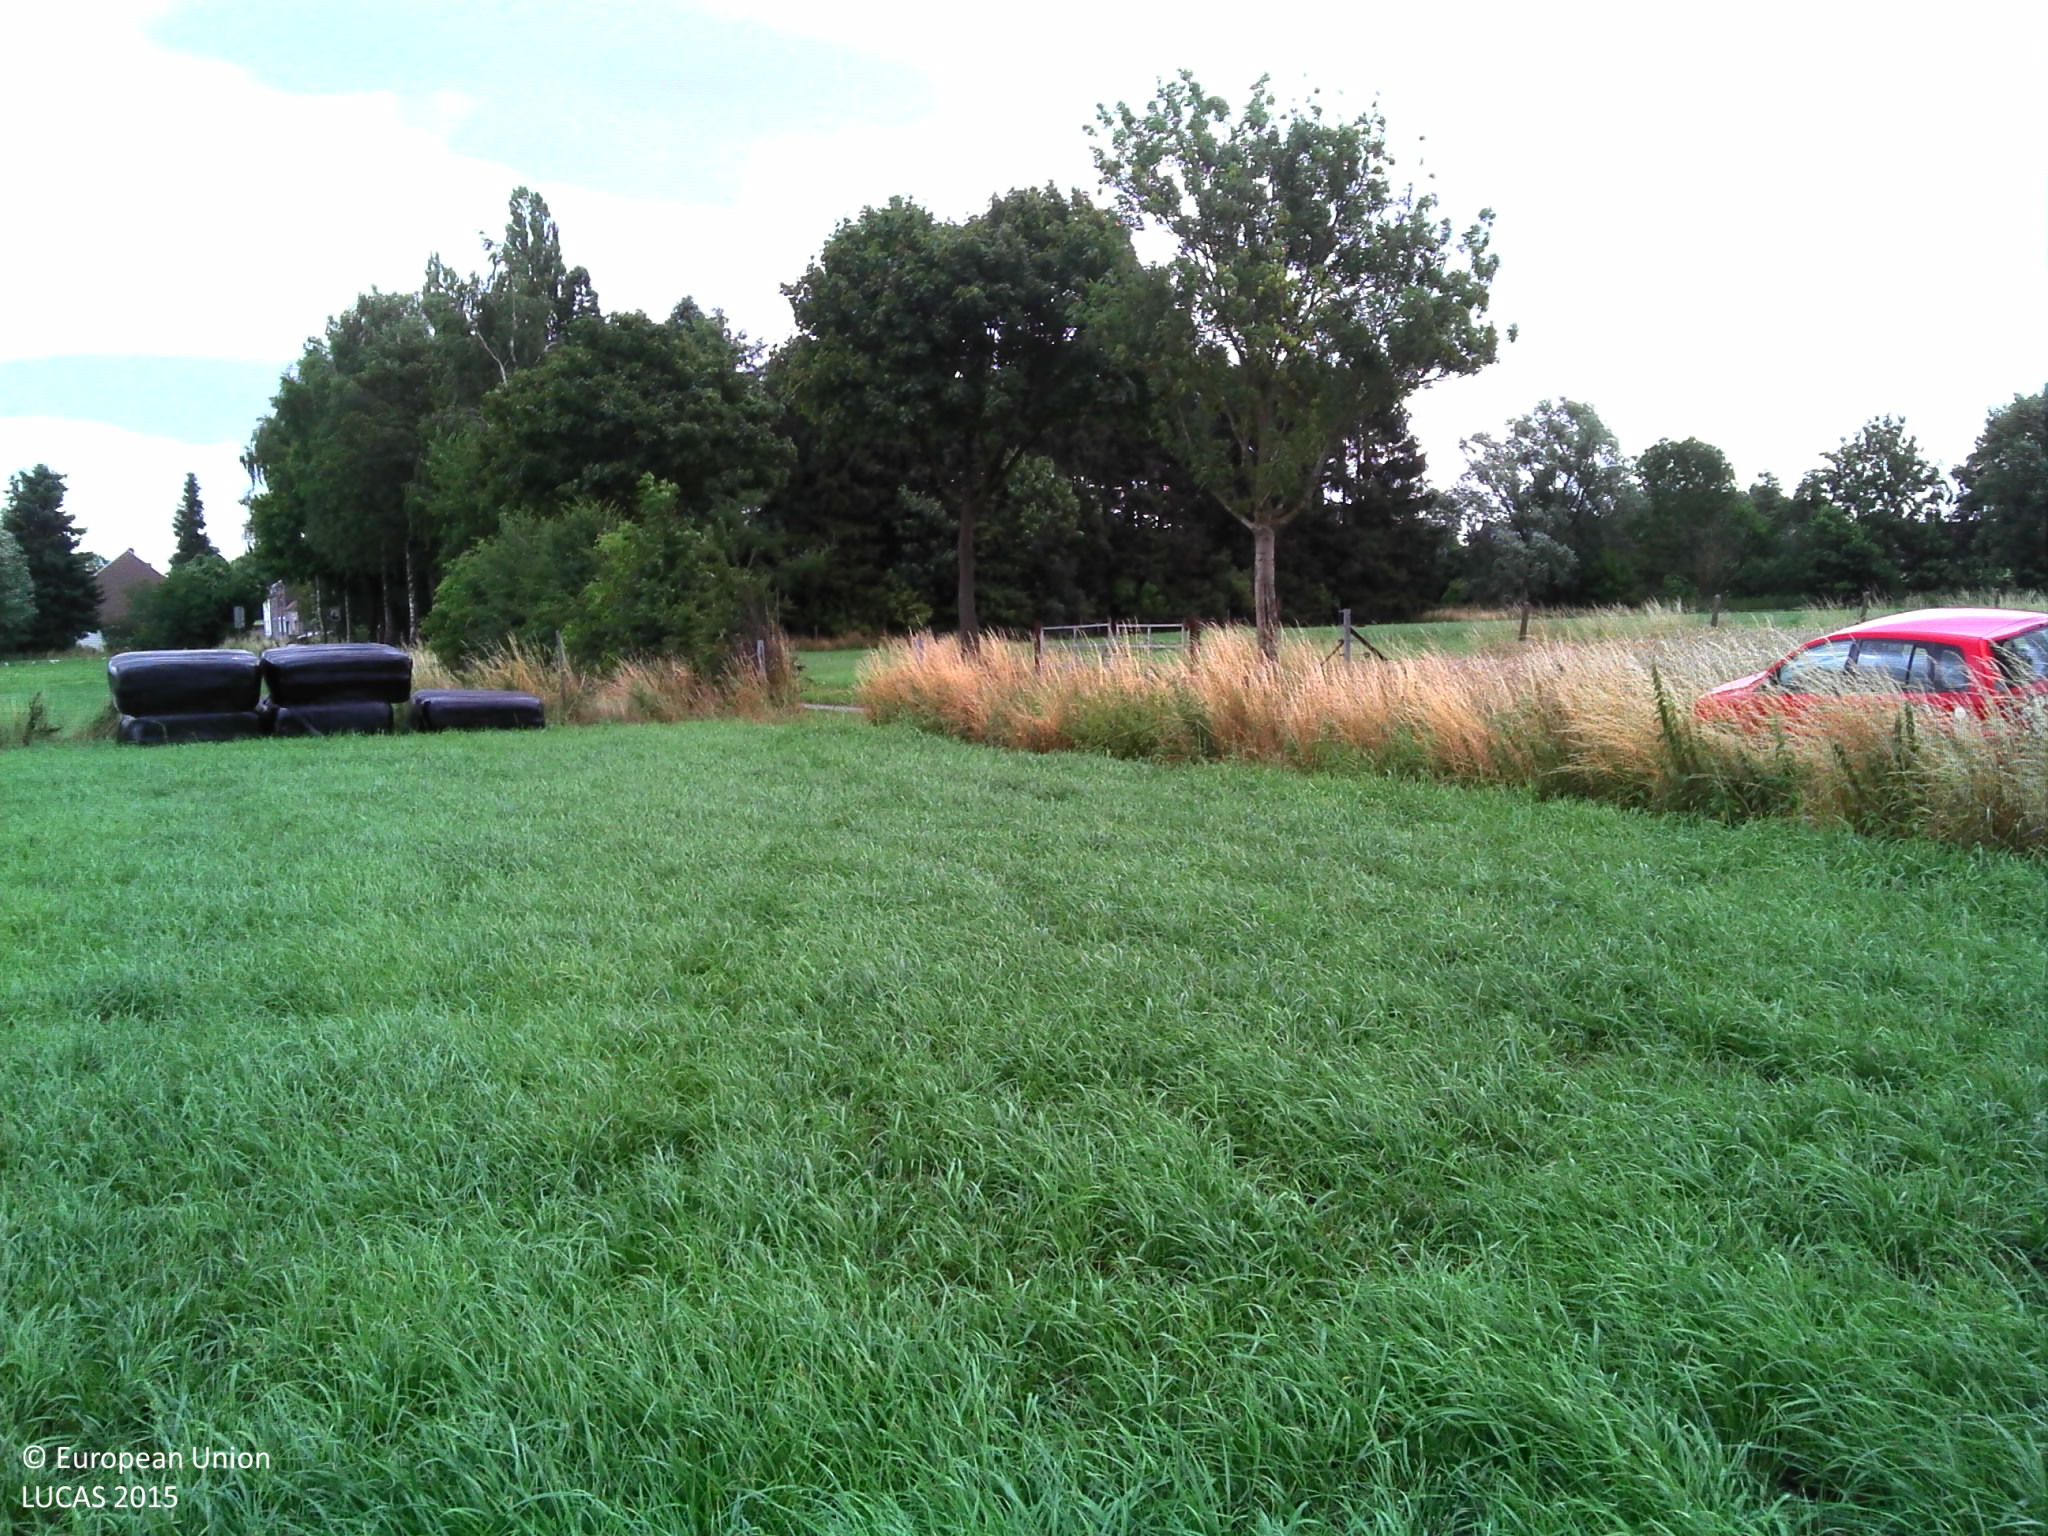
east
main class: Cropland
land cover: Temporary grasslands
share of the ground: > 75 %
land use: Agriculture (excluding fallow land and kitchen gardens)
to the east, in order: Temporary grasslands; Fences; Grass margins; Paved roads, cycling and walking lanes; Grass margins; Lines of trees; Fences; Temporary grasslands; Fences; Spruce dominated mixed woodland; Ditches and canals; Temporary grasslands; Abandoned hedges; Broadleaved woodland; Abandoned hedges
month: July
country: BE
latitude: 50.5013
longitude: 4.4832
